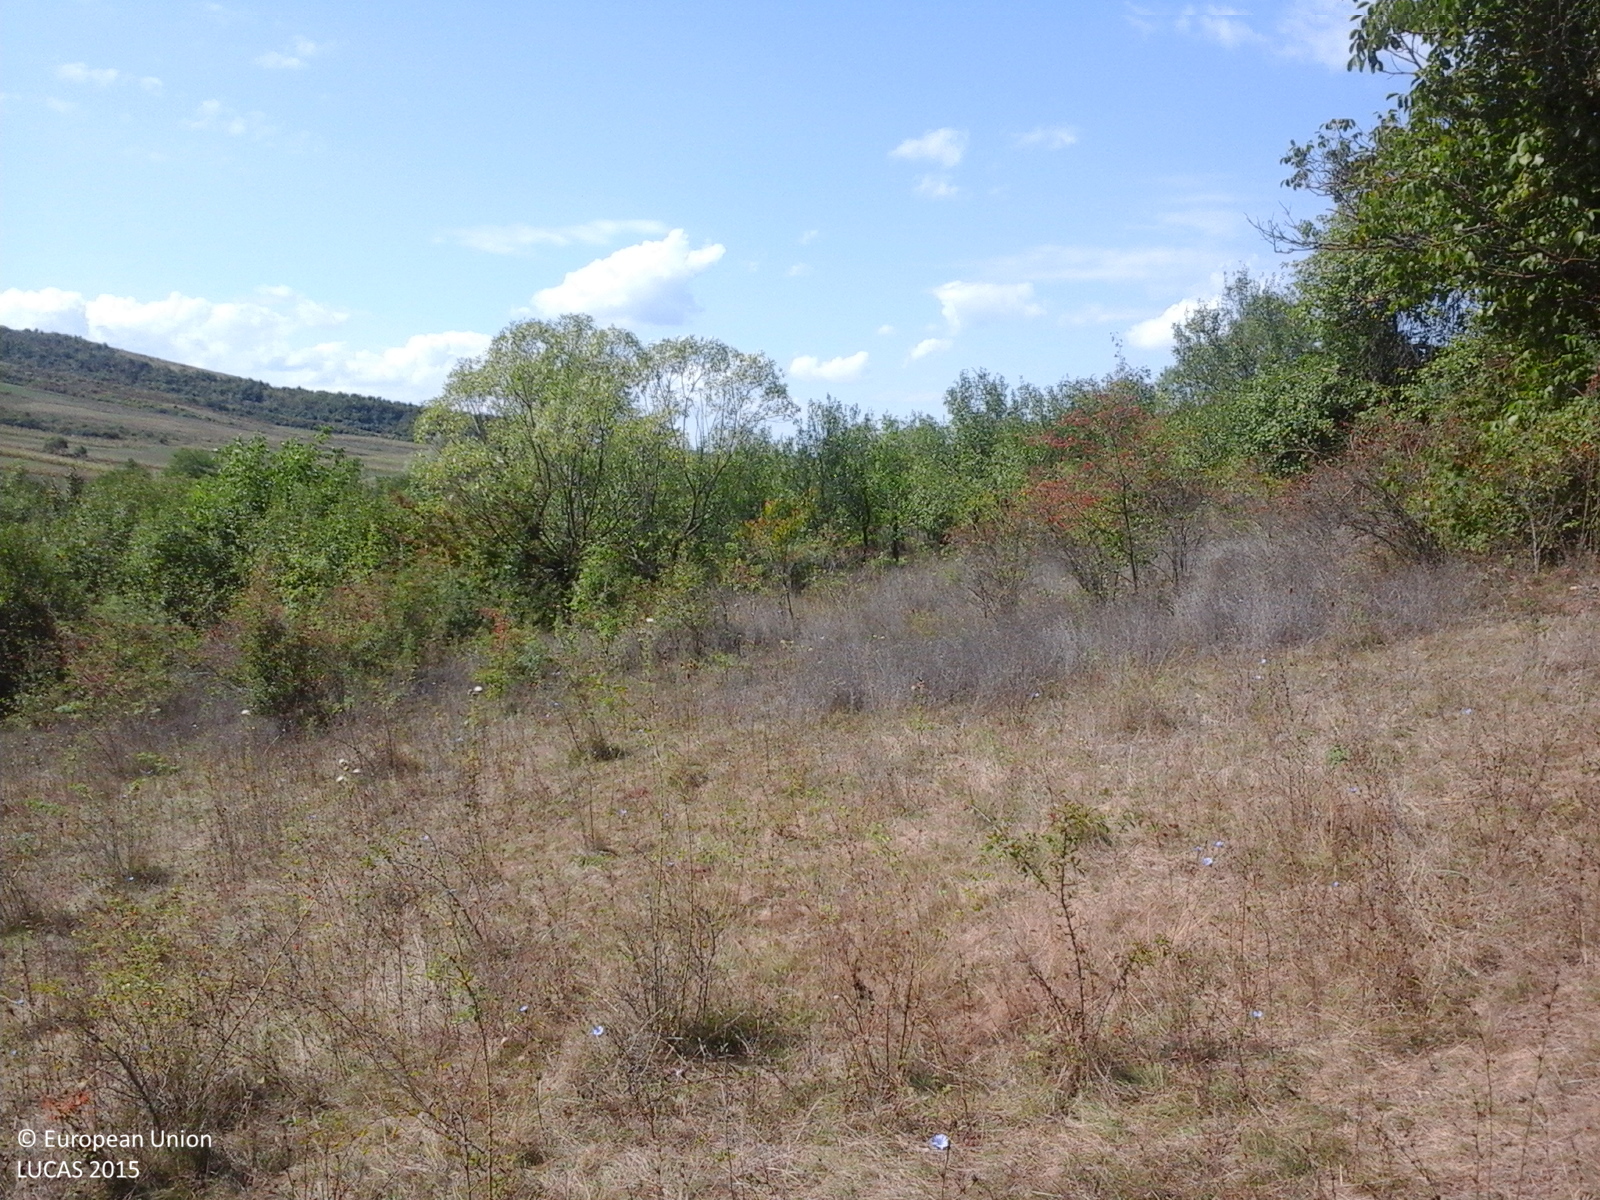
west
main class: Grassland
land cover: Grassland with sparse tree/shrub cover
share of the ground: > 75 %
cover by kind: herbaceous plants 95 %, broadleaved forest trees 5 %
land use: Agriculture (excluding fallow land and kitchen gardens)
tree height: > 5 m
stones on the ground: < 10 %
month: September
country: RO
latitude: 47.3655
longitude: 23.2438
